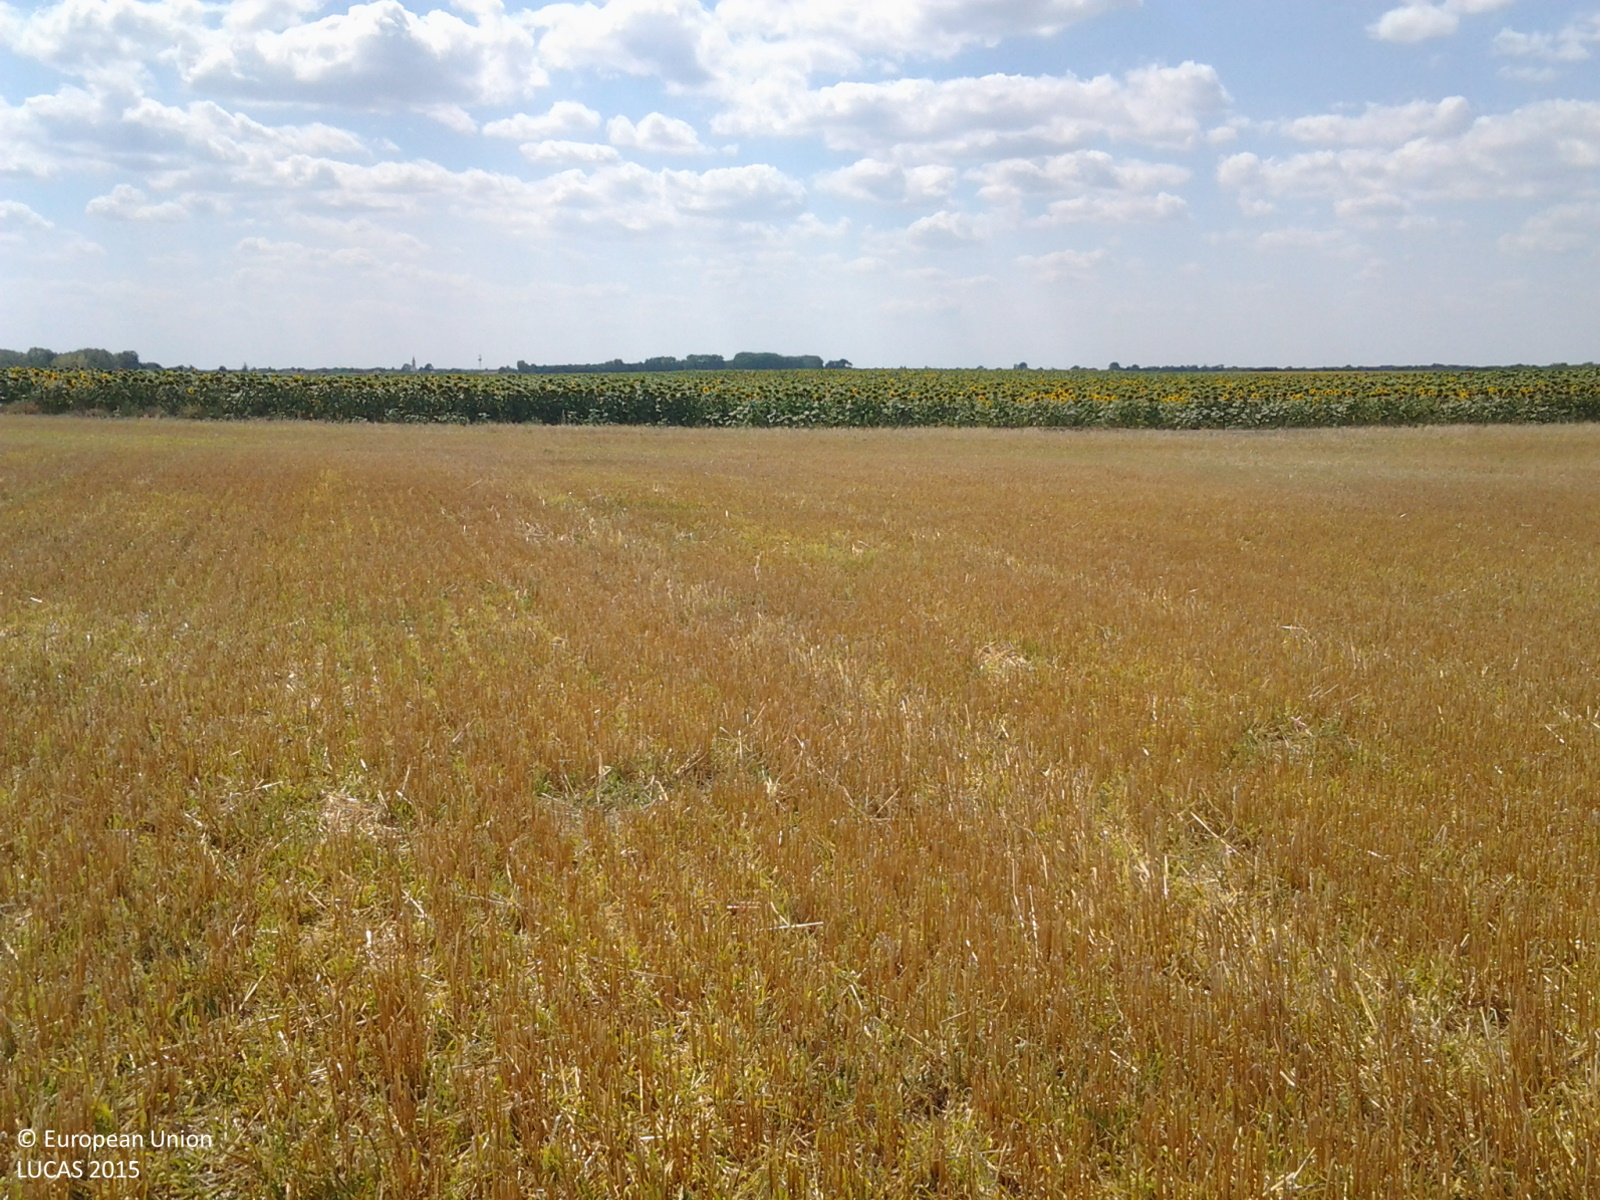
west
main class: Cropland
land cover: Barley
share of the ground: 10 - 25 %
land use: Agriculture (excluding fallow land and kitchen gardens)
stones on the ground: < 10 %
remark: Harvested field
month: July
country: HU
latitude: 47.3905
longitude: 20.5364
